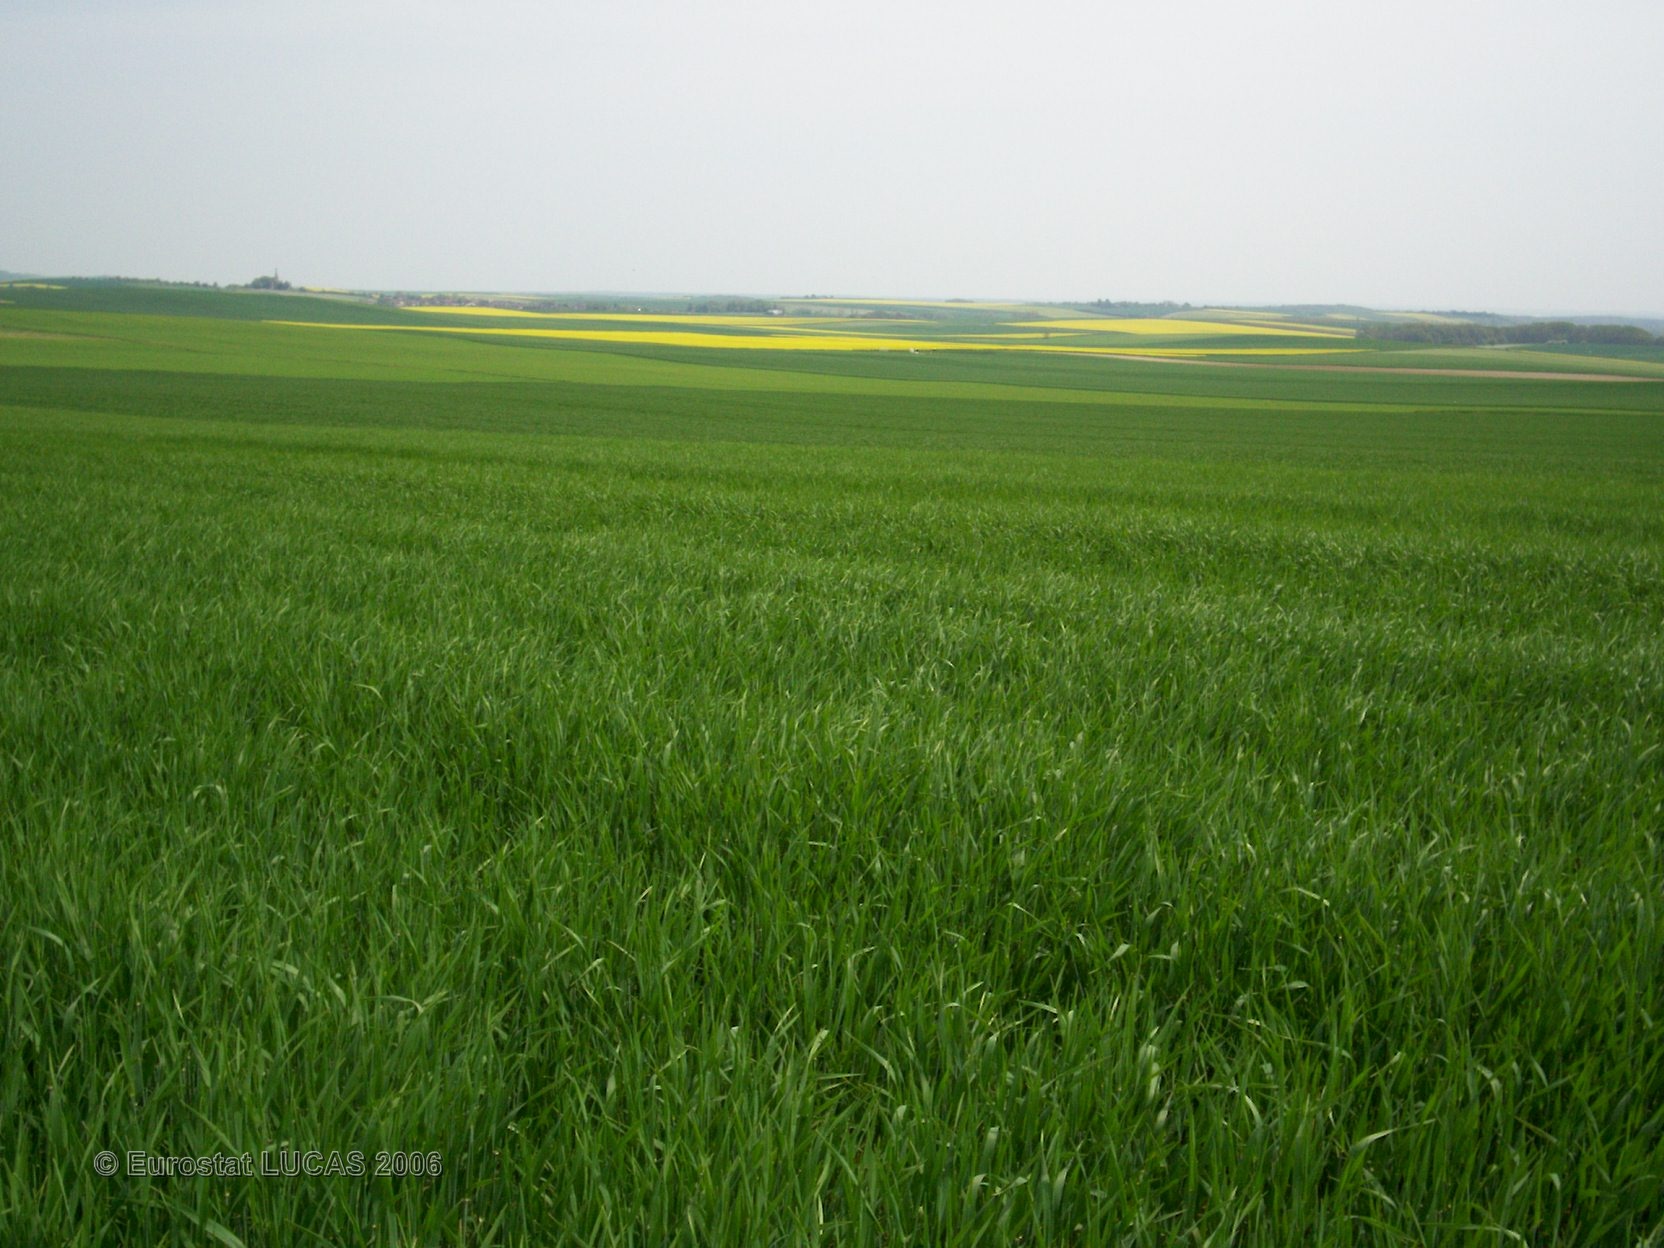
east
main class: Cropland
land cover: Barley
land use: Agriculture (excluding fallow land and kitchen gardens)
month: May
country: FR
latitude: 48.0855
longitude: 3.8071
